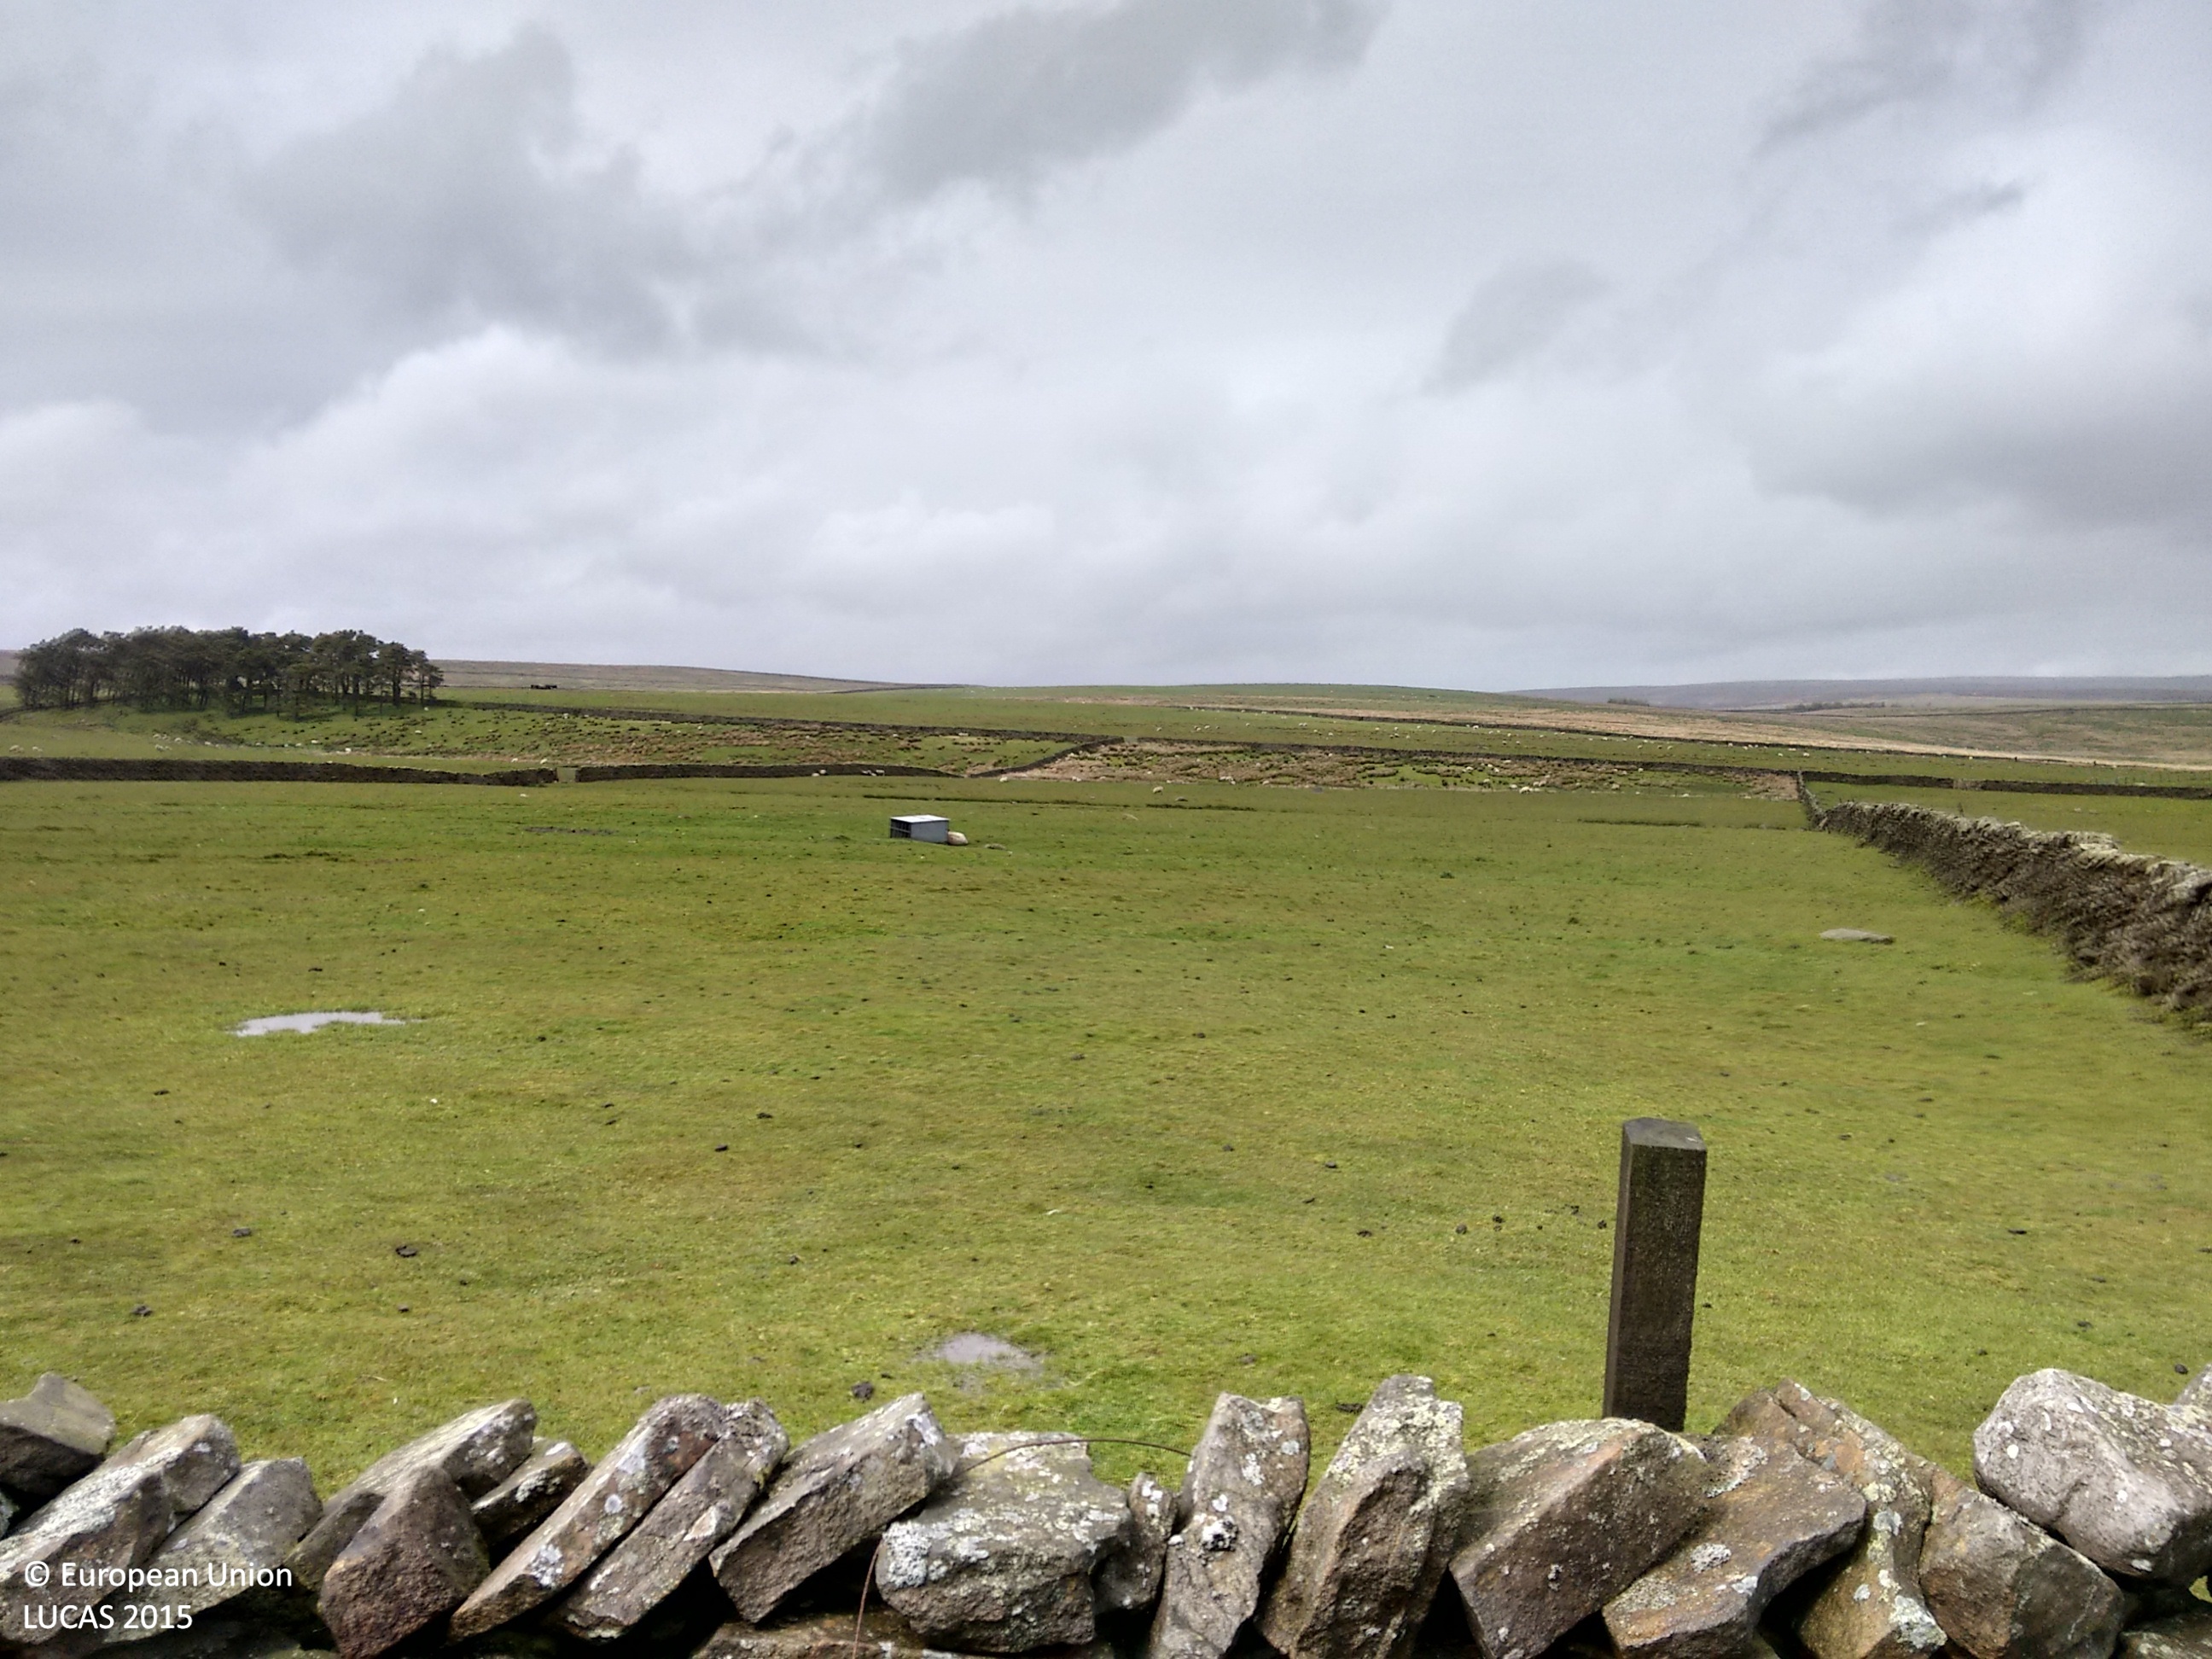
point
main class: Grassland
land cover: Grassland without tree/shrub cover
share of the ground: > 75 %
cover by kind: herbaceous plants 100 %
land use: Agriculture (excluding fallow land and kitchen gardens)
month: June
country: GB
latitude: 54.0646
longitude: -1.9275
